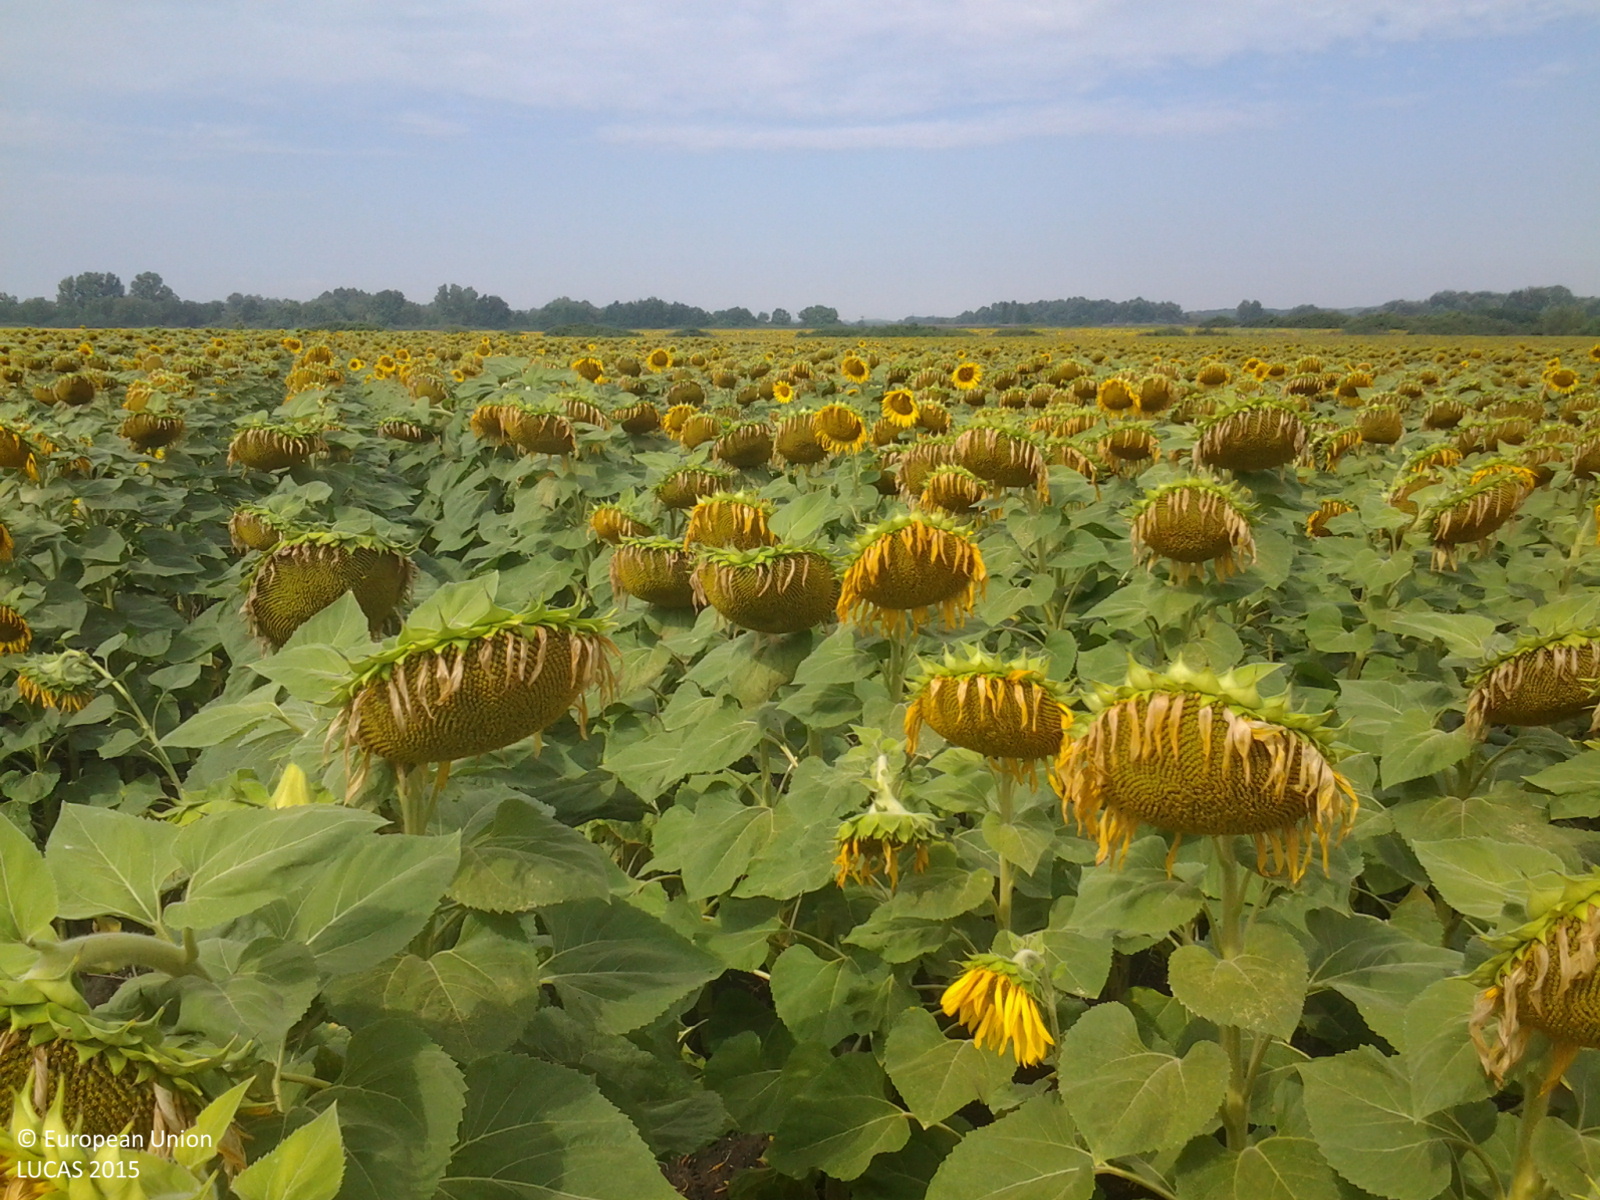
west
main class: Cropland
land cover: Sunflower
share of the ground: > 75 %
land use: Agriculture (excluding fallow land and kitchen gardens)
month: August
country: HU
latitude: 46.9762
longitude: 21.2235
